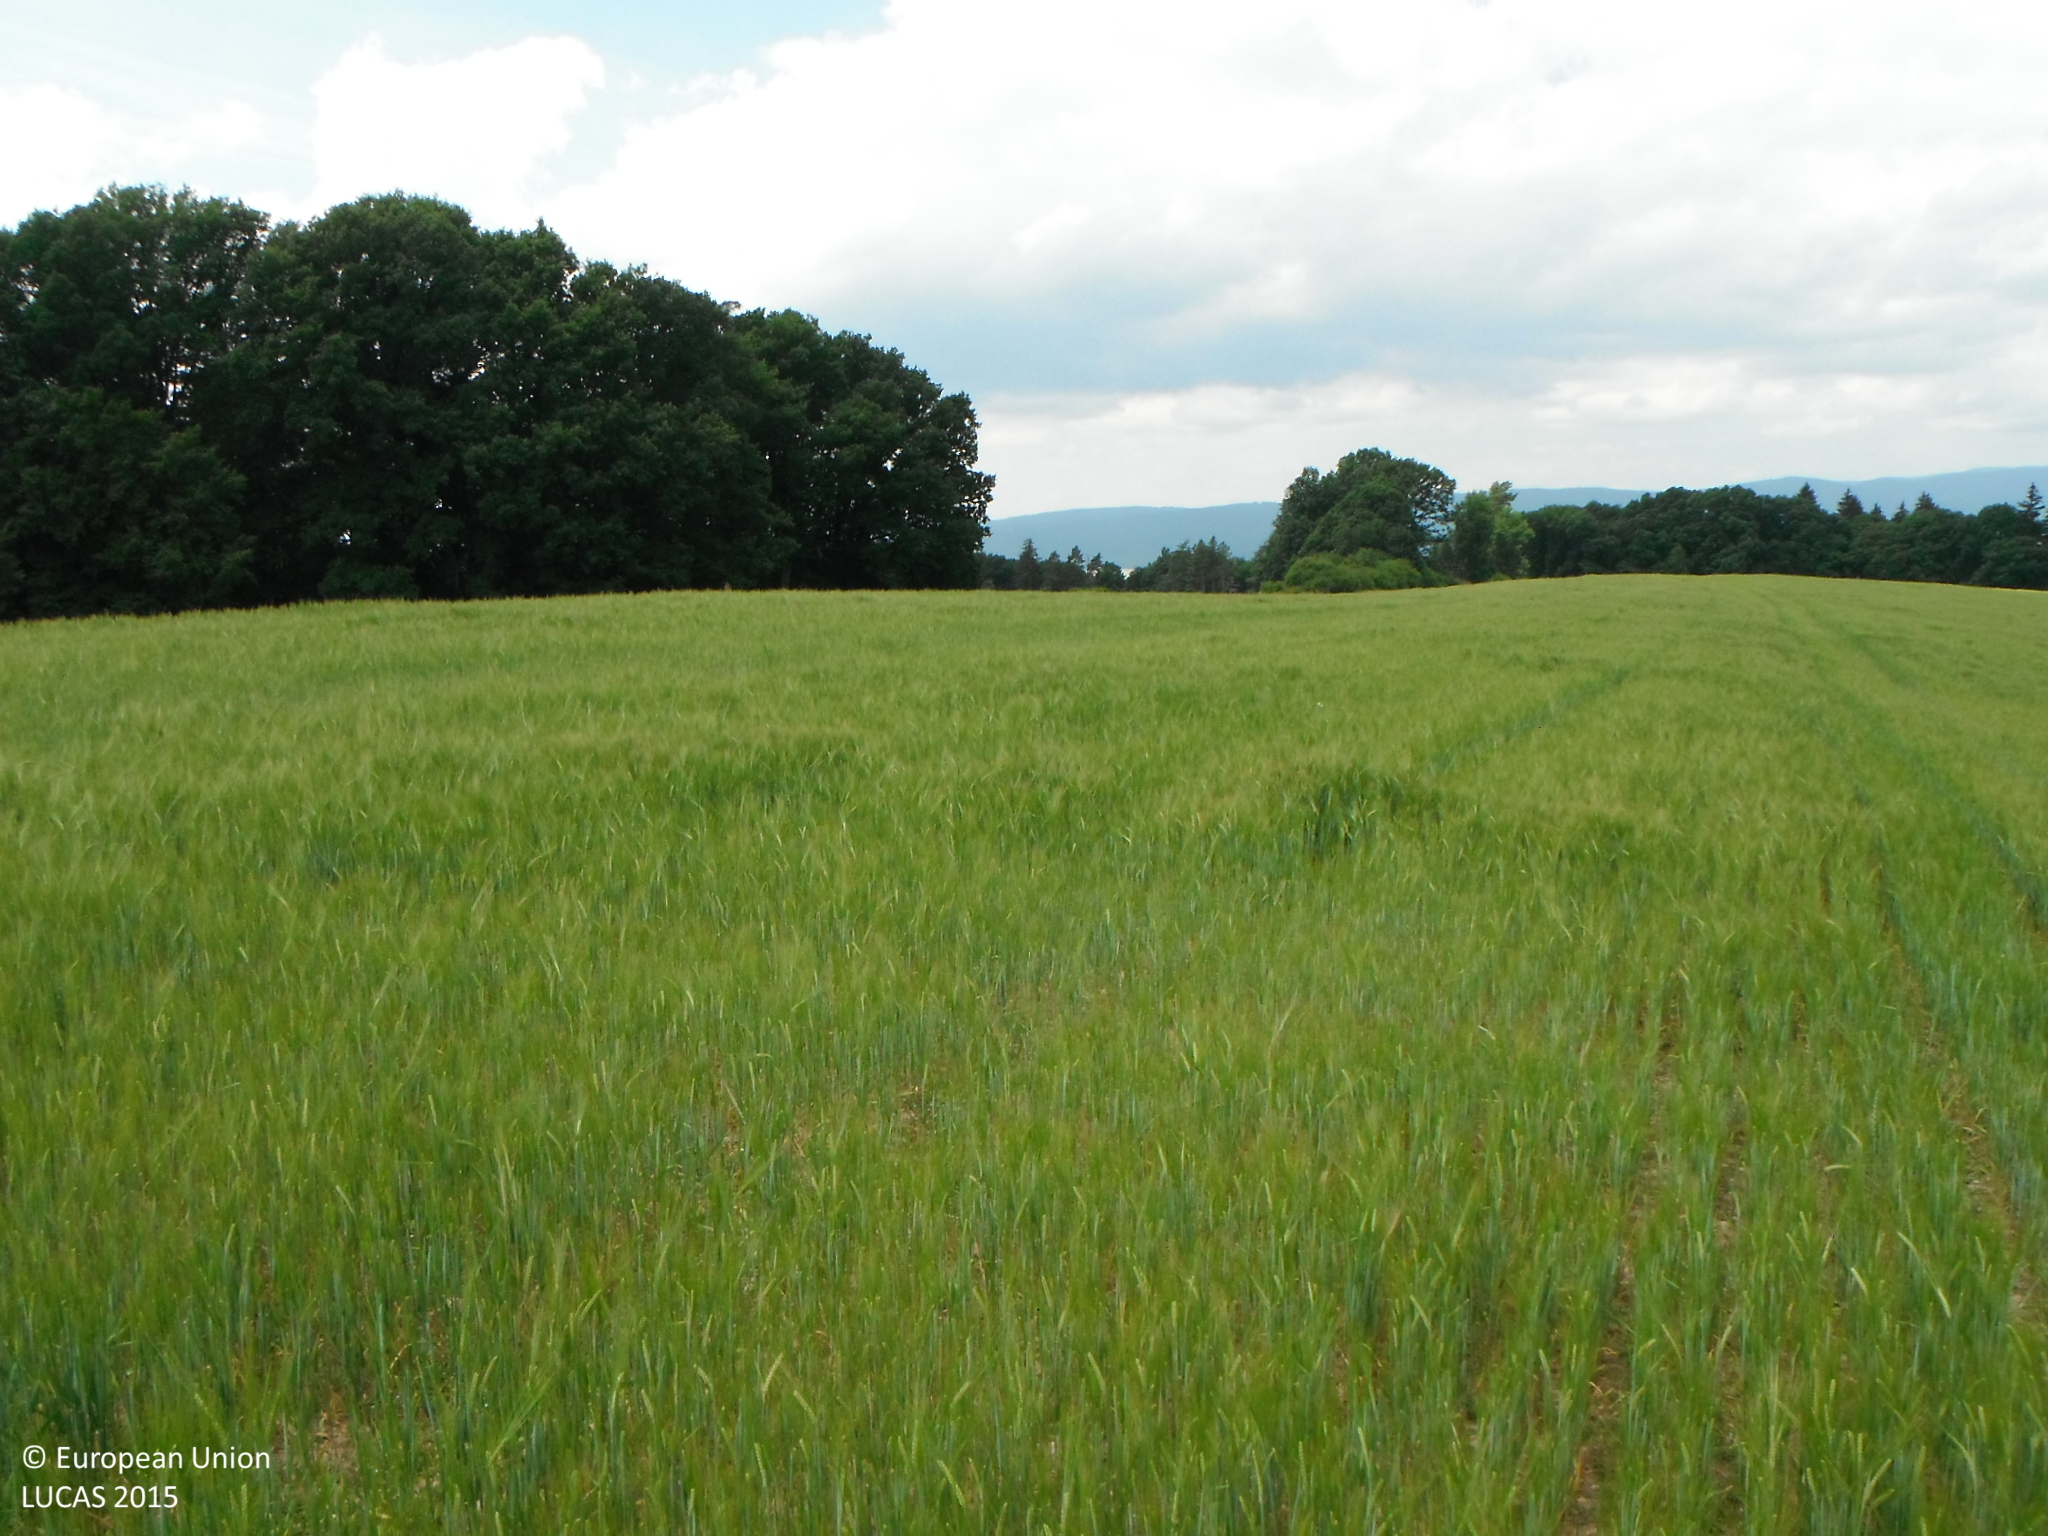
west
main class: Cropland
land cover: Barley
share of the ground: > 75 %
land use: Agriculture (excluding fallow land and kitchen gardens)
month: June
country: SK
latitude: 48.6185
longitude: 19.1790
